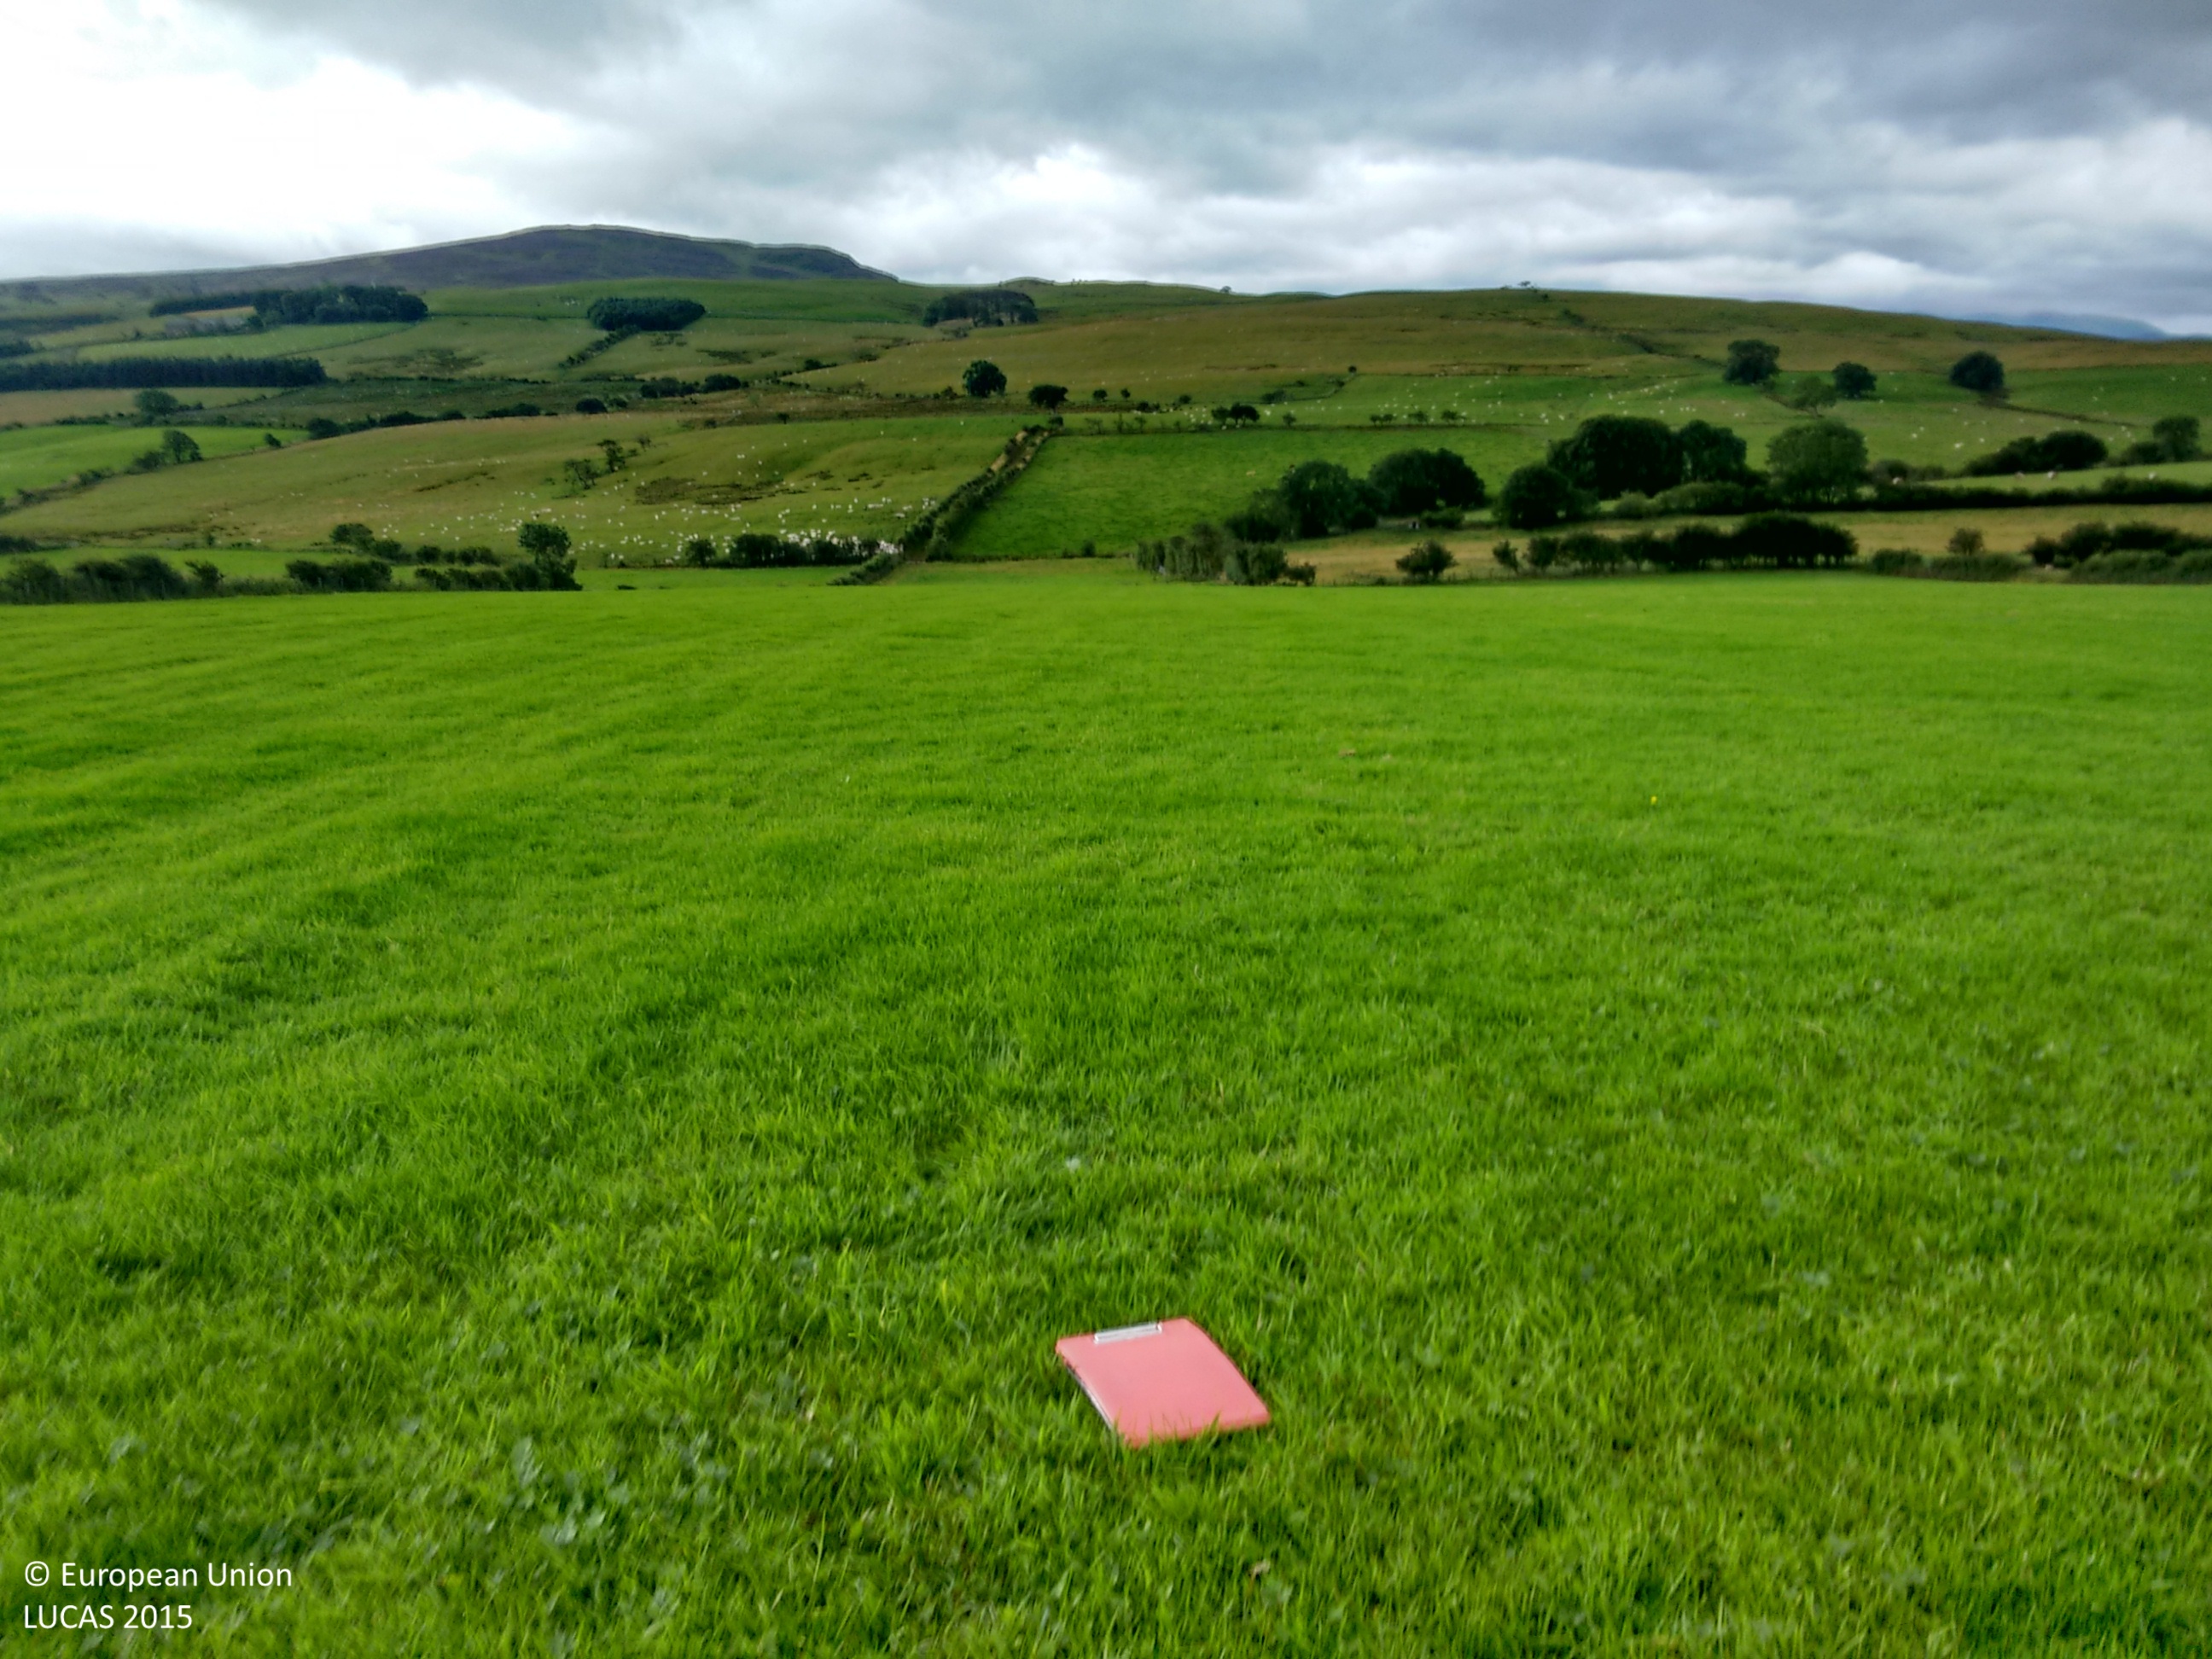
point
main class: Grassland
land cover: Grassland without tree/shrub cover
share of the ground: > 75 %
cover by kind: herbaceous plants 100 %
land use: Agriculture (excluding fallow land and kitchen gardens)
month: August
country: GB
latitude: 54.7325
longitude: -3.2299
